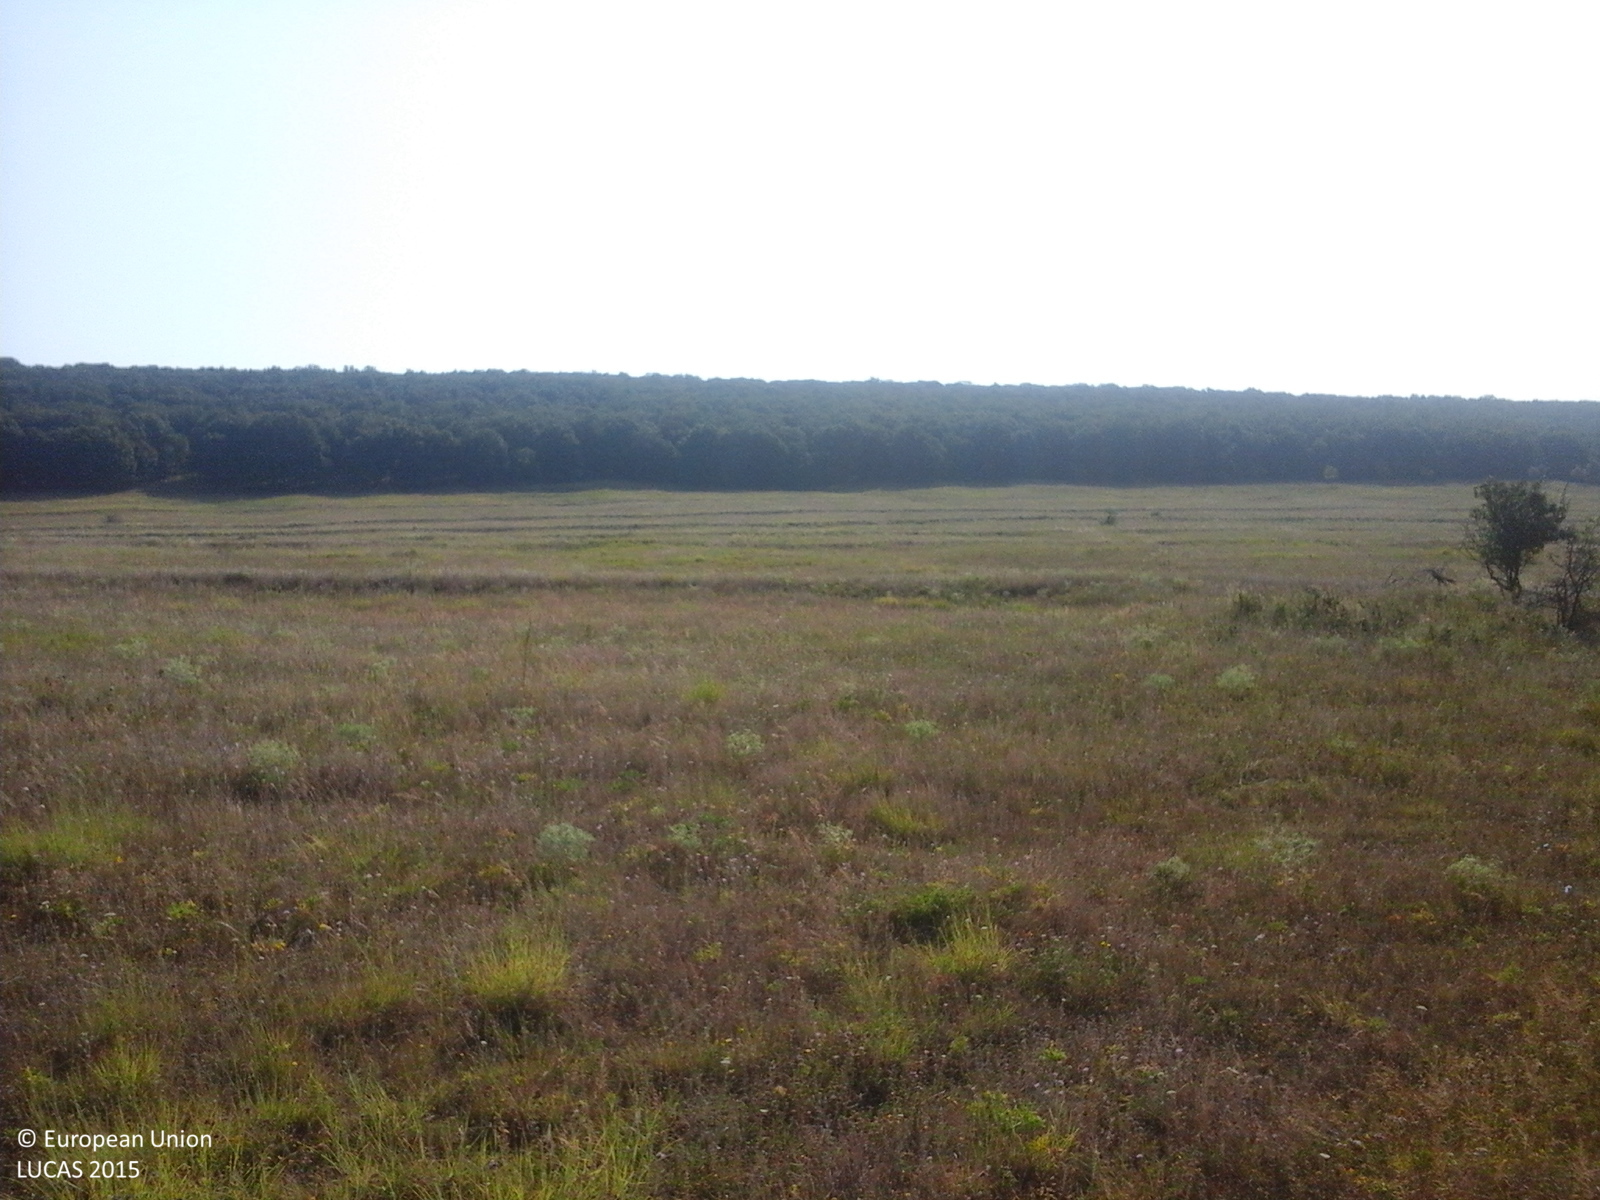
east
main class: Grassland
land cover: Grassland with sparse tree/shrub cover
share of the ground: > 75 %
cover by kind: herbaceous plants 95 %, broadleaved forest trees 5 %
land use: Agriculture (excluding fallow land and kitchen gardens)
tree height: > 5 m
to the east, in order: Grassland with sparse tree/shrub cover; Grassland without tree/shrub cover
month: July
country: RO
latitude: 46.4740
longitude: 27.6319
